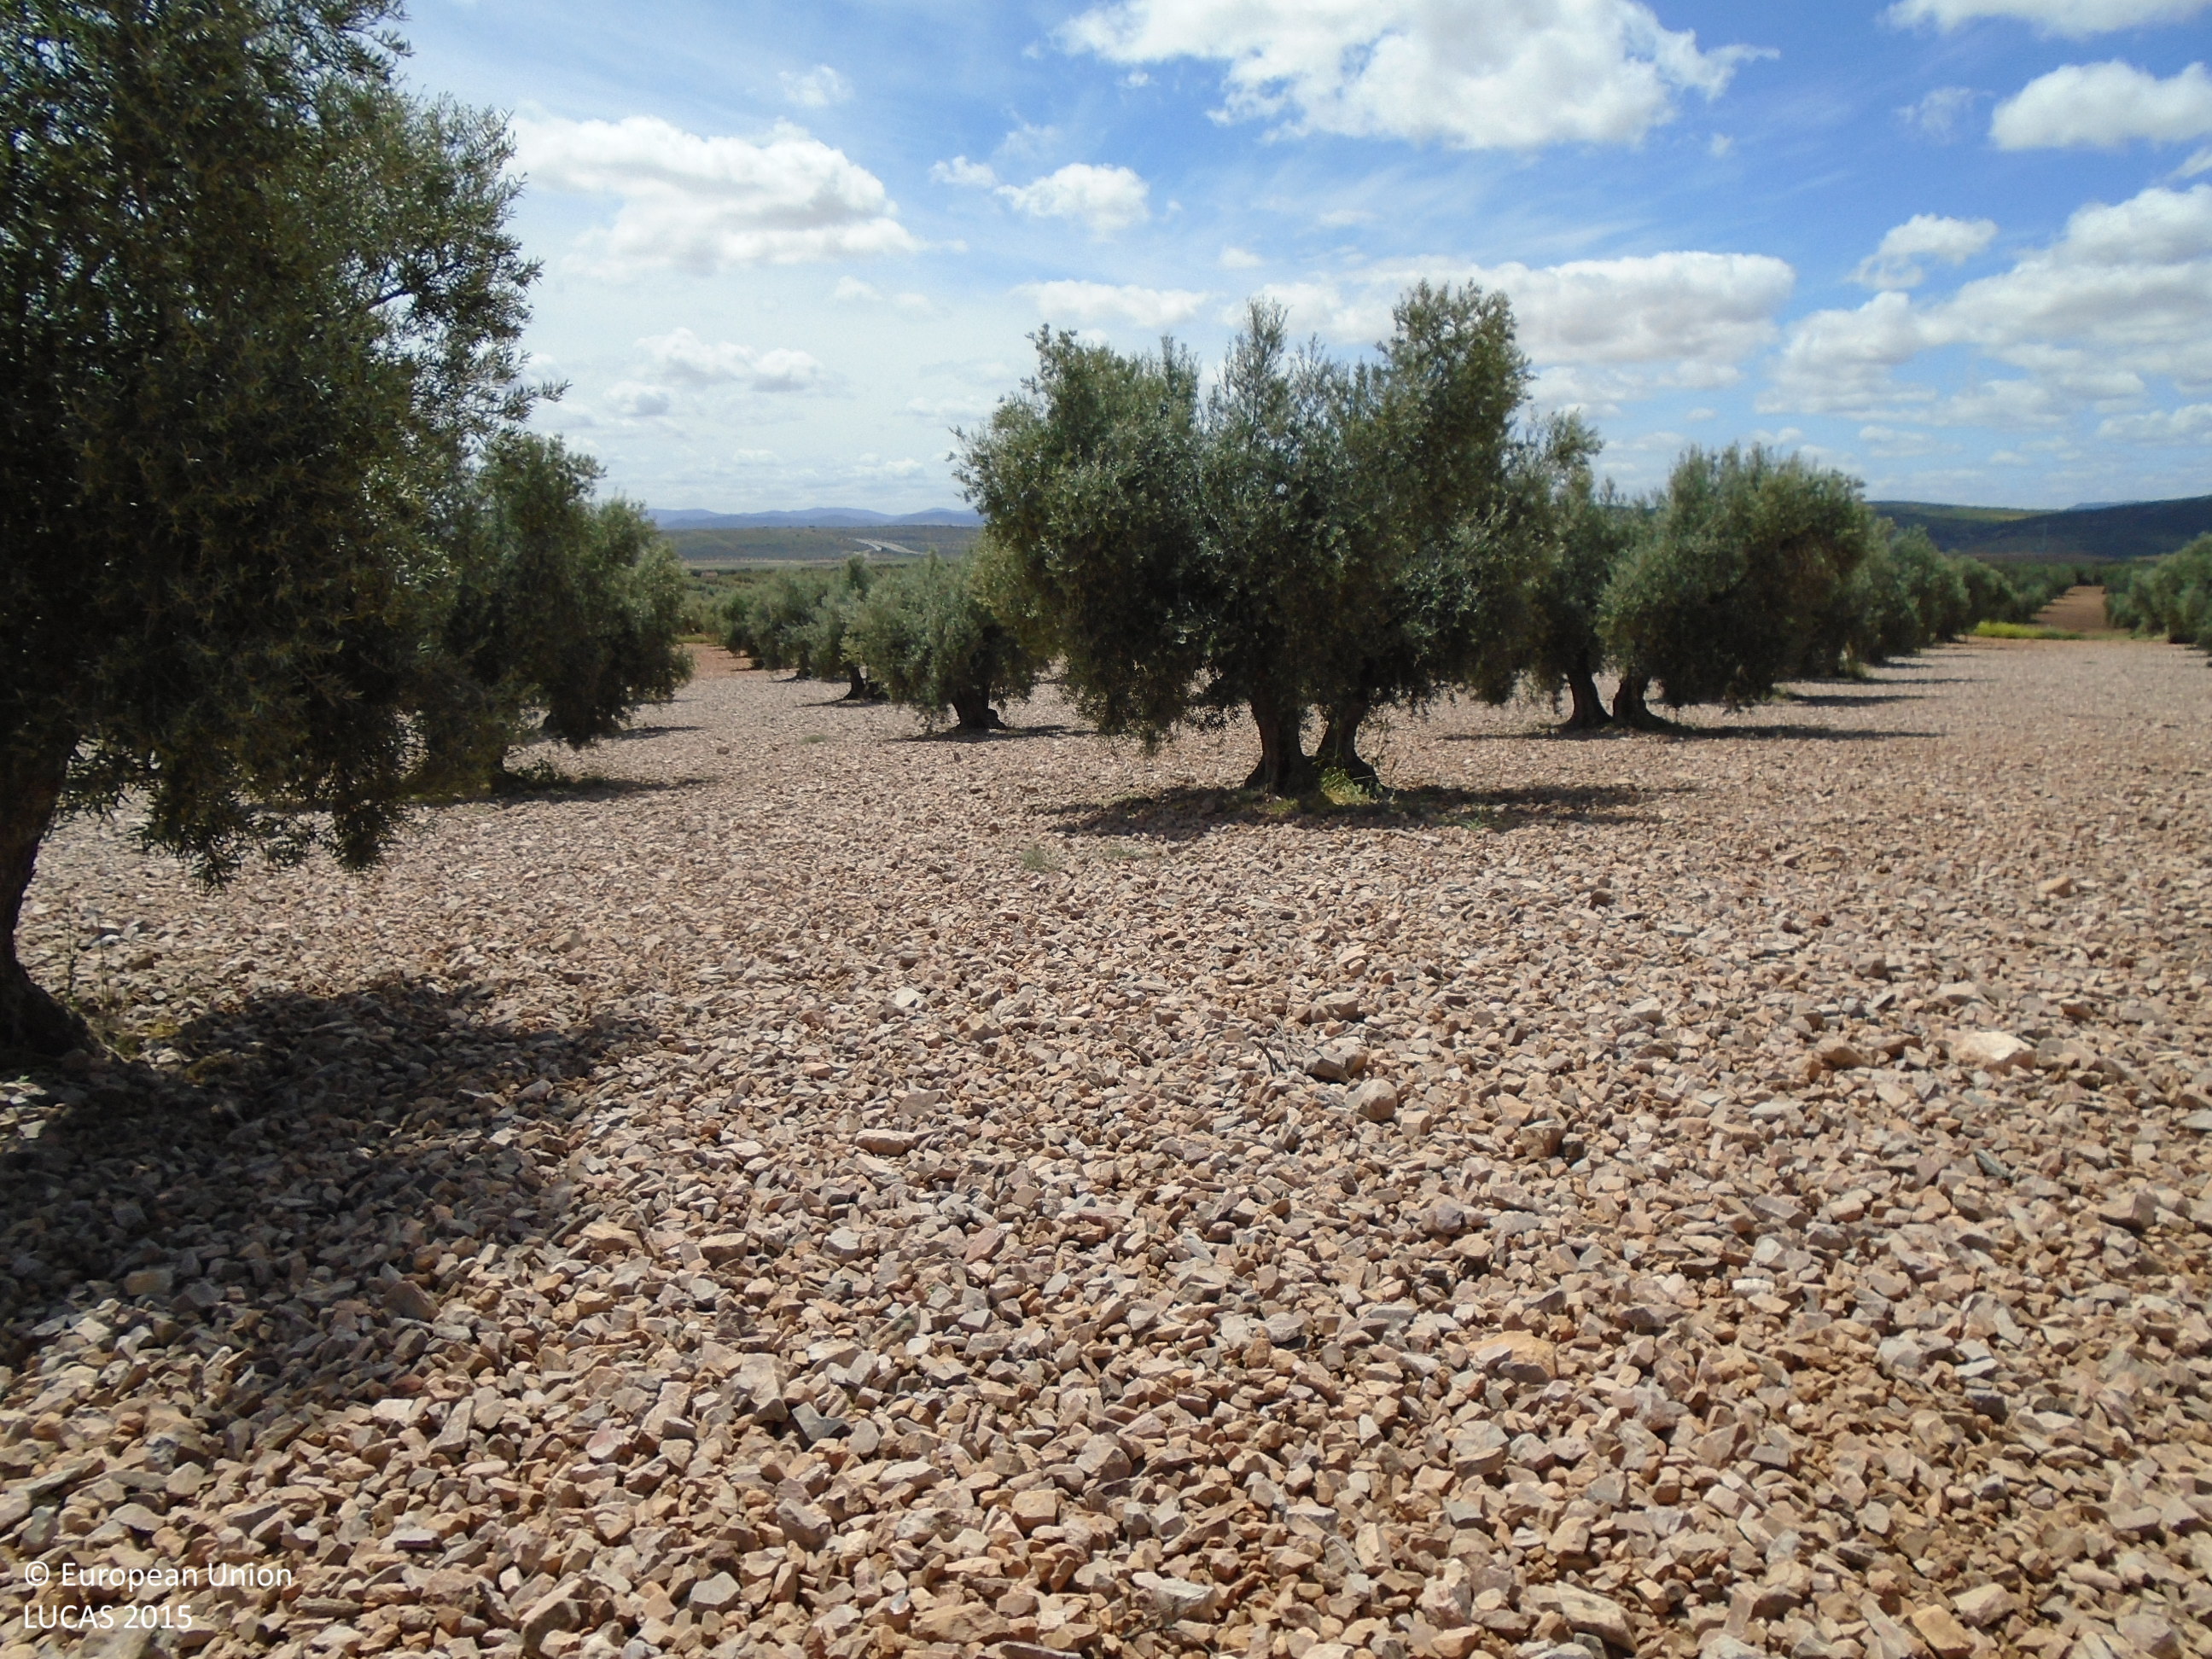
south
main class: Cropland
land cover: Olive groves
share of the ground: 10 - 25 %
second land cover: Other bare soil
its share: > 75 %
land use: Agriculture (excluding fallow land and kitchen gardens)
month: May
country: ES
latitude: 39.6288
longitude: -3.7164
